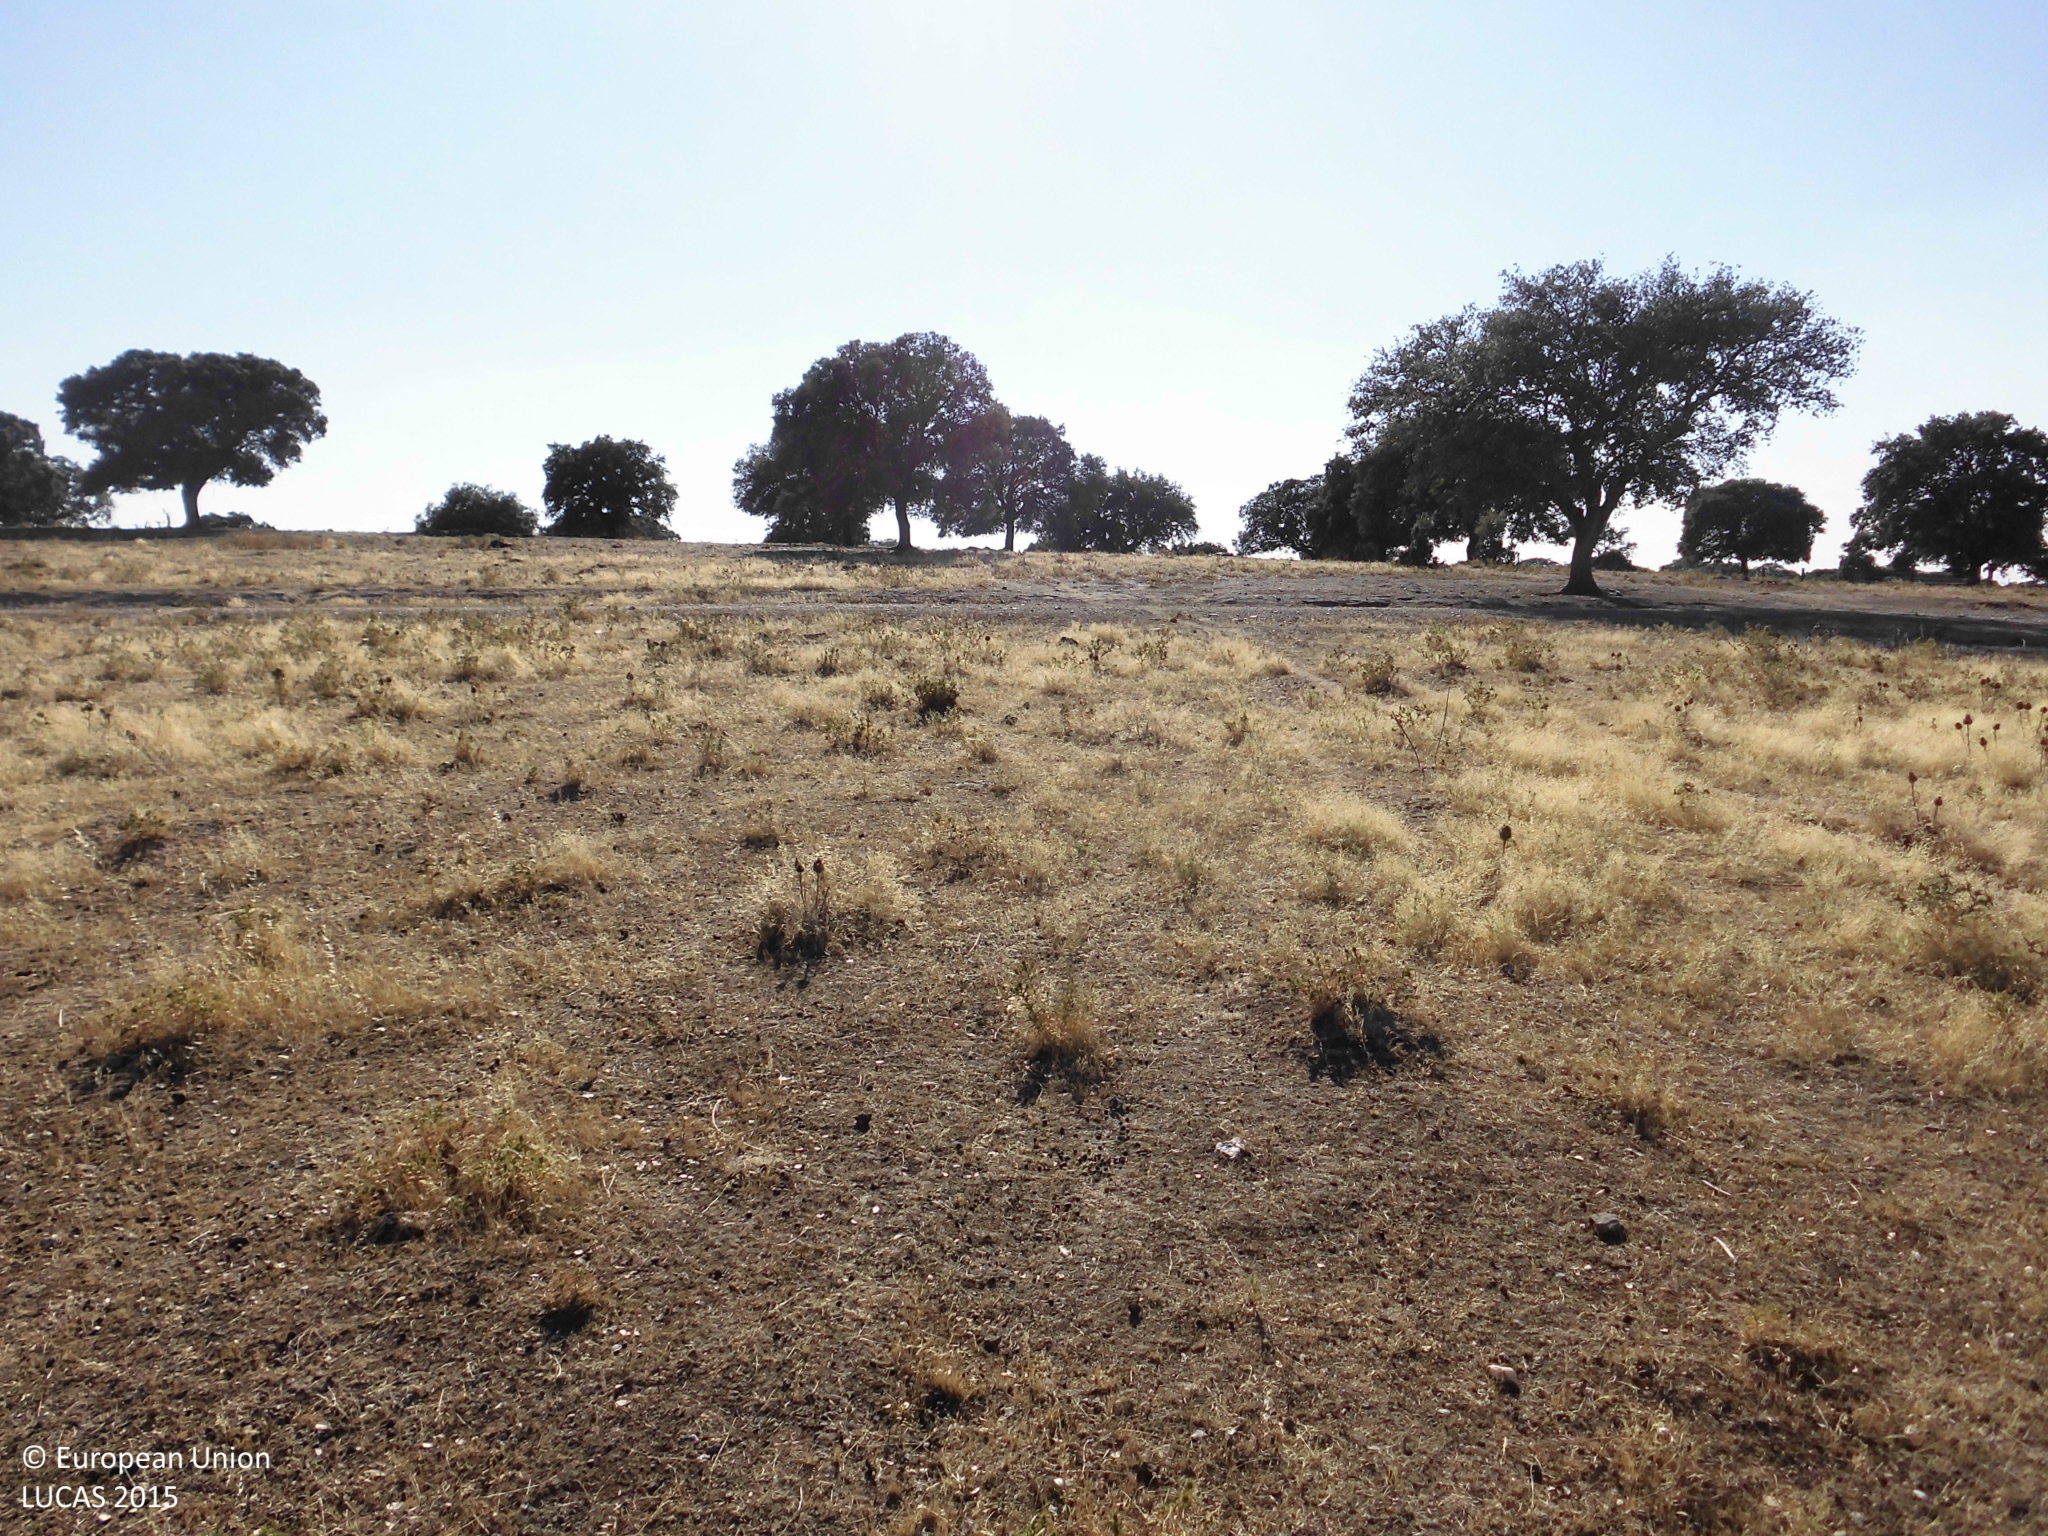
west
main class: Woodland
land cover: Broadleaved woodland
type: broadleaved evergreen forest
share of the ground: 10 - 25 %
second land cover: Grassland without tree/shrub cover
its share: > 75 %
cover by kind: herbaceous plants 90 %, broadleaved forest trees 10 %
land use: Forestry
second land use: Agriculture (excluding fallow land and kitchen gardens)
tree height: > 5 m
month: June
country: ES
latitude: 39.6198
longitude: -6.0344
